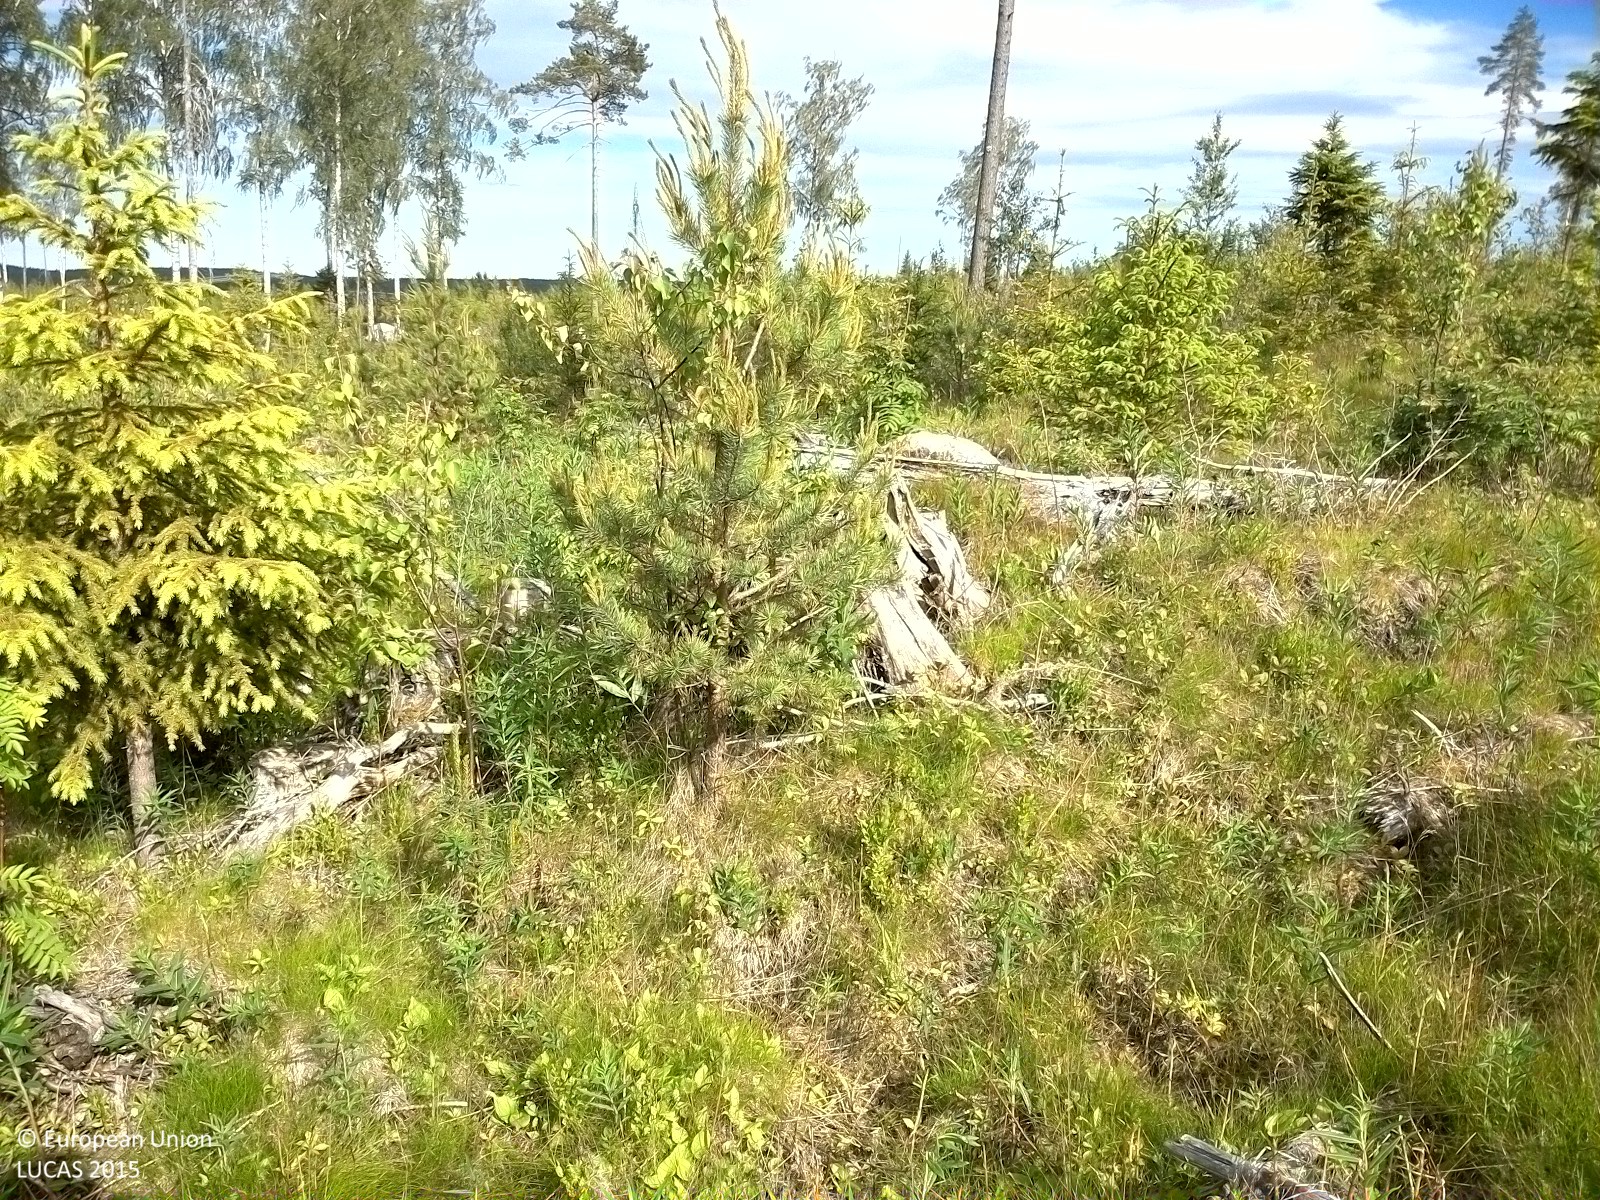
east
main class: Woodland
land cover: Spruce dominated mixed woodland
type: boreal forest
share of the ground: 10 - 25 %
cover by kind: herbaceous plants 60 %, coniferous forest trees 15 %, shrubs 15 %, broadleaved forest trees 10 %
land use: Forestry
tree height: < 5 m
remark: Clear cut
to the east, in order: Spruce dominated mixed woodland; Broadleaved woodland
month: July
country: SE
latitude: 62.1460
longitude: 16.9073
